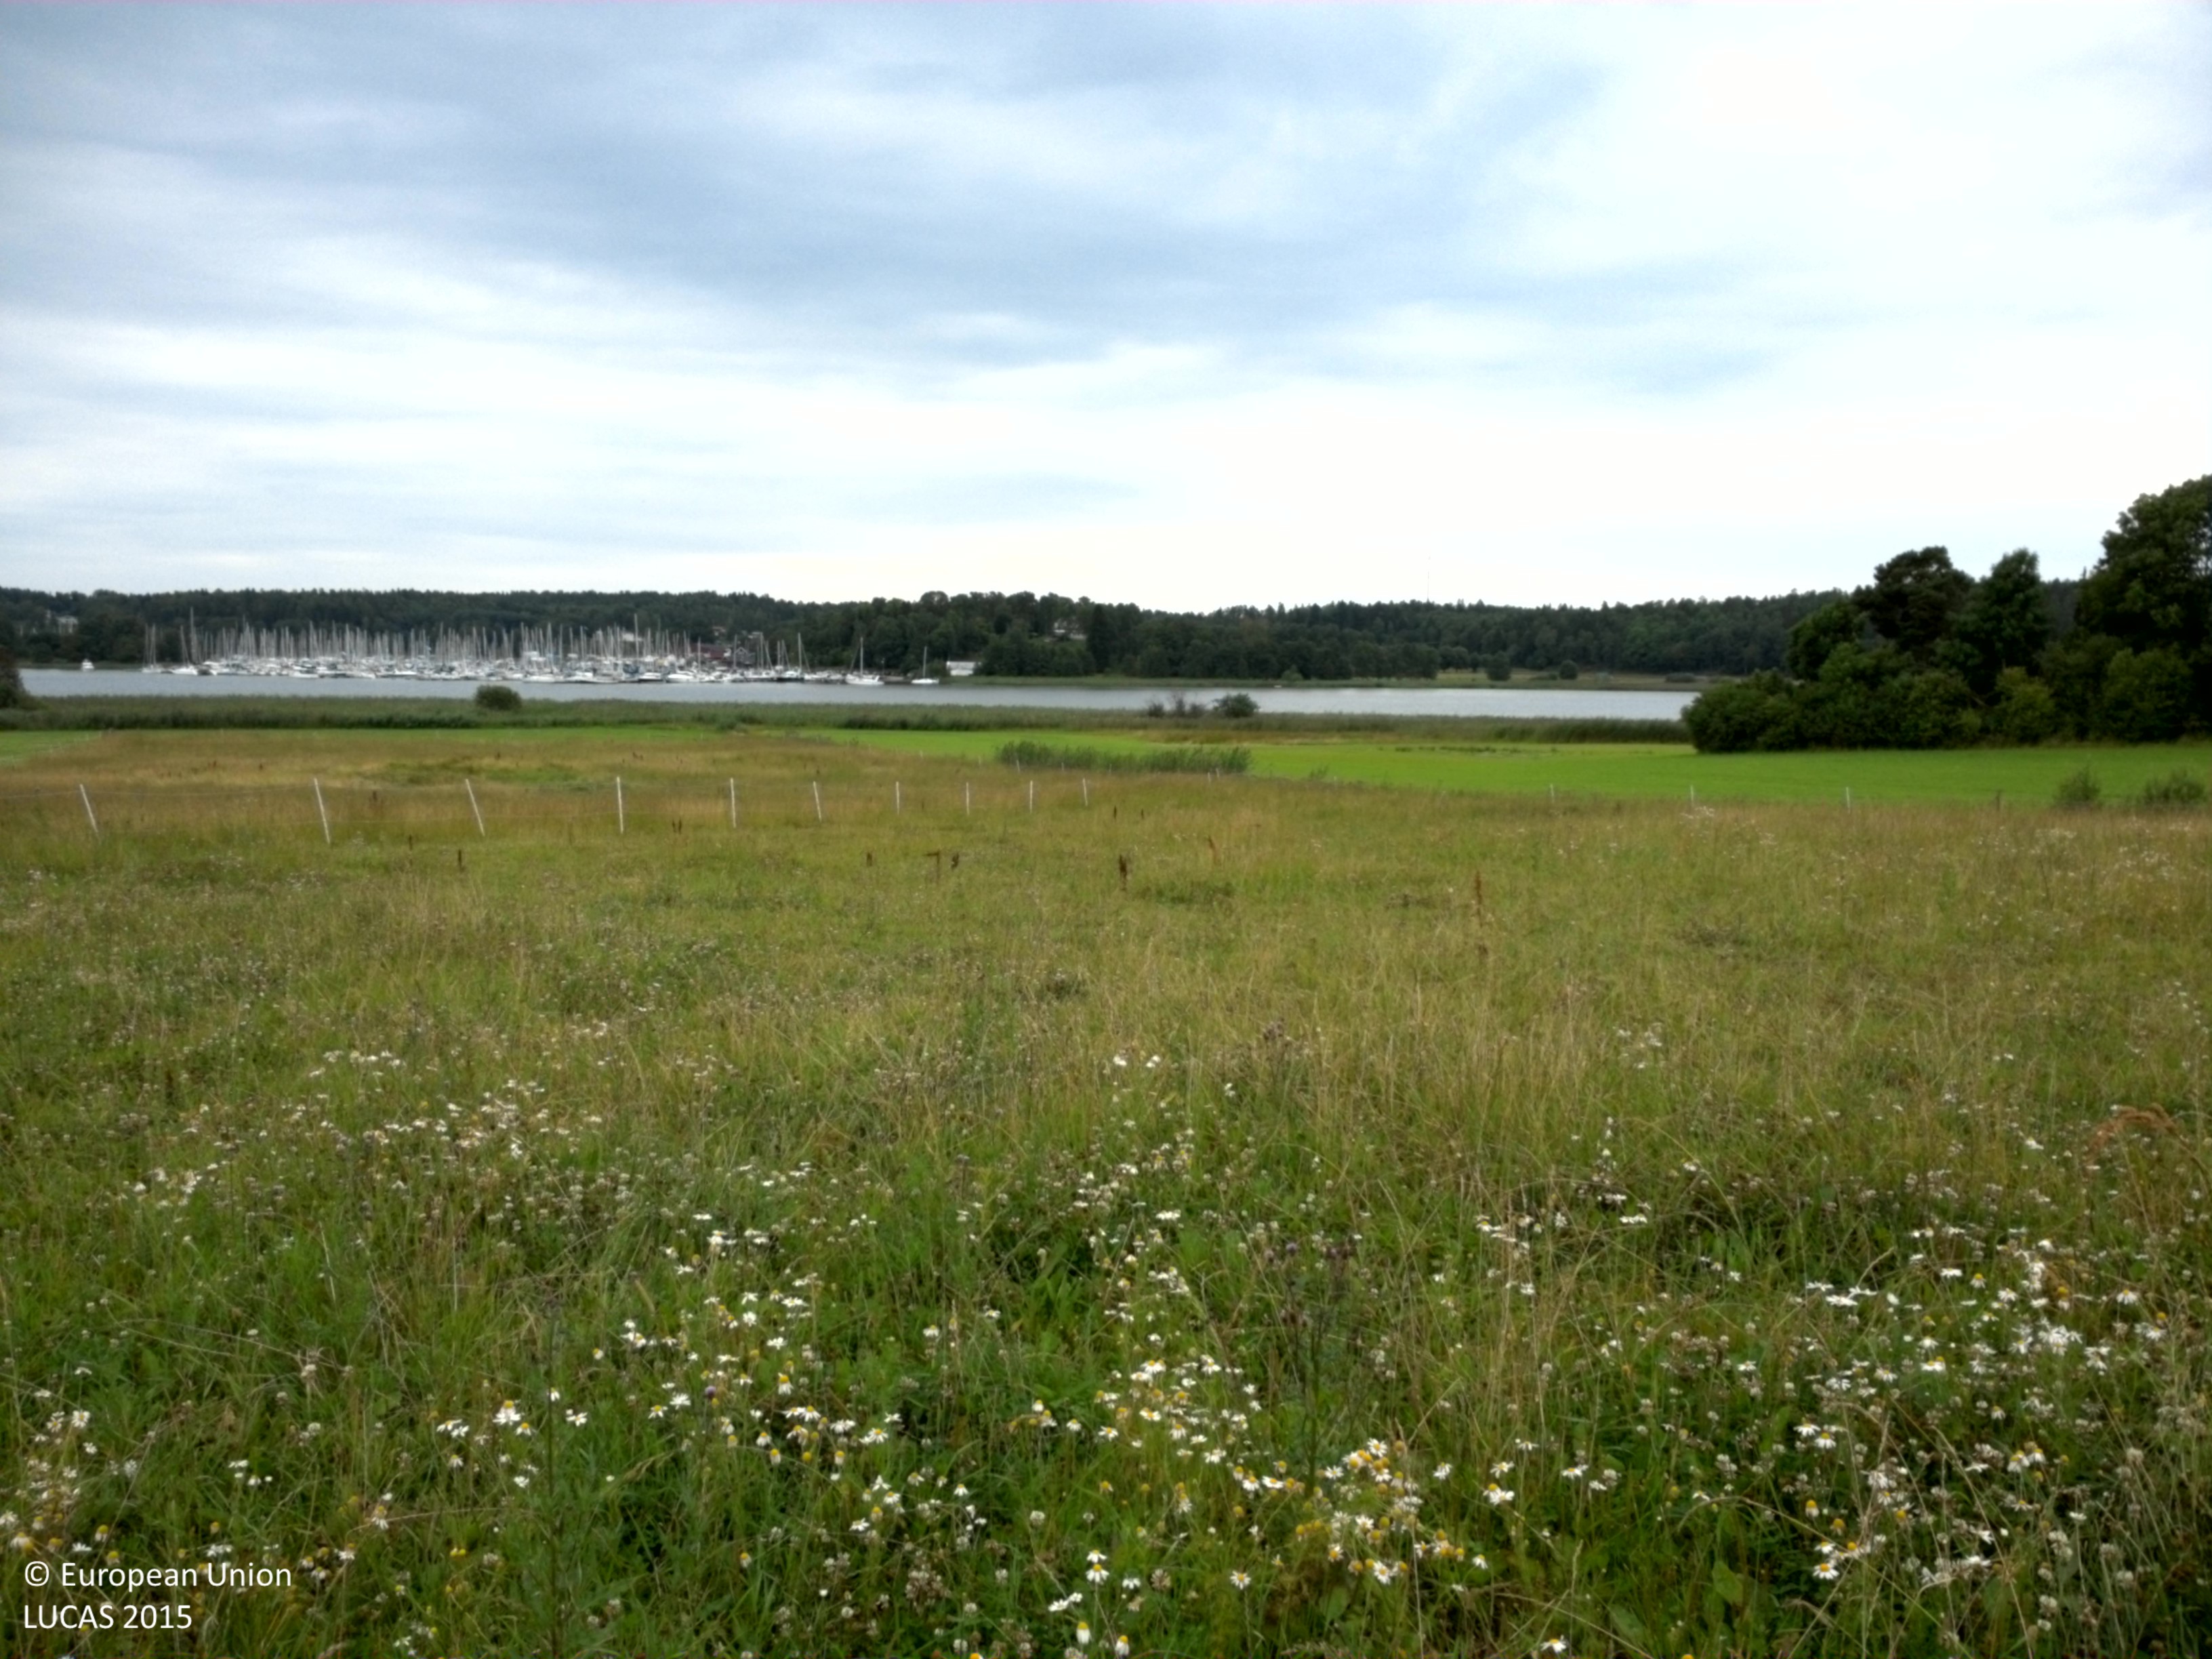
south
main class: Grassland
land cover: Grassland without tree/shrub cover
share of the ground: > 75 %
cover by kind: herbaceous plants 100 %
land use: Agriculture (excluding fallow land and kitchen gardens)
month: July
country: SE
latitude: 59.4665
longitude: 18.2754
